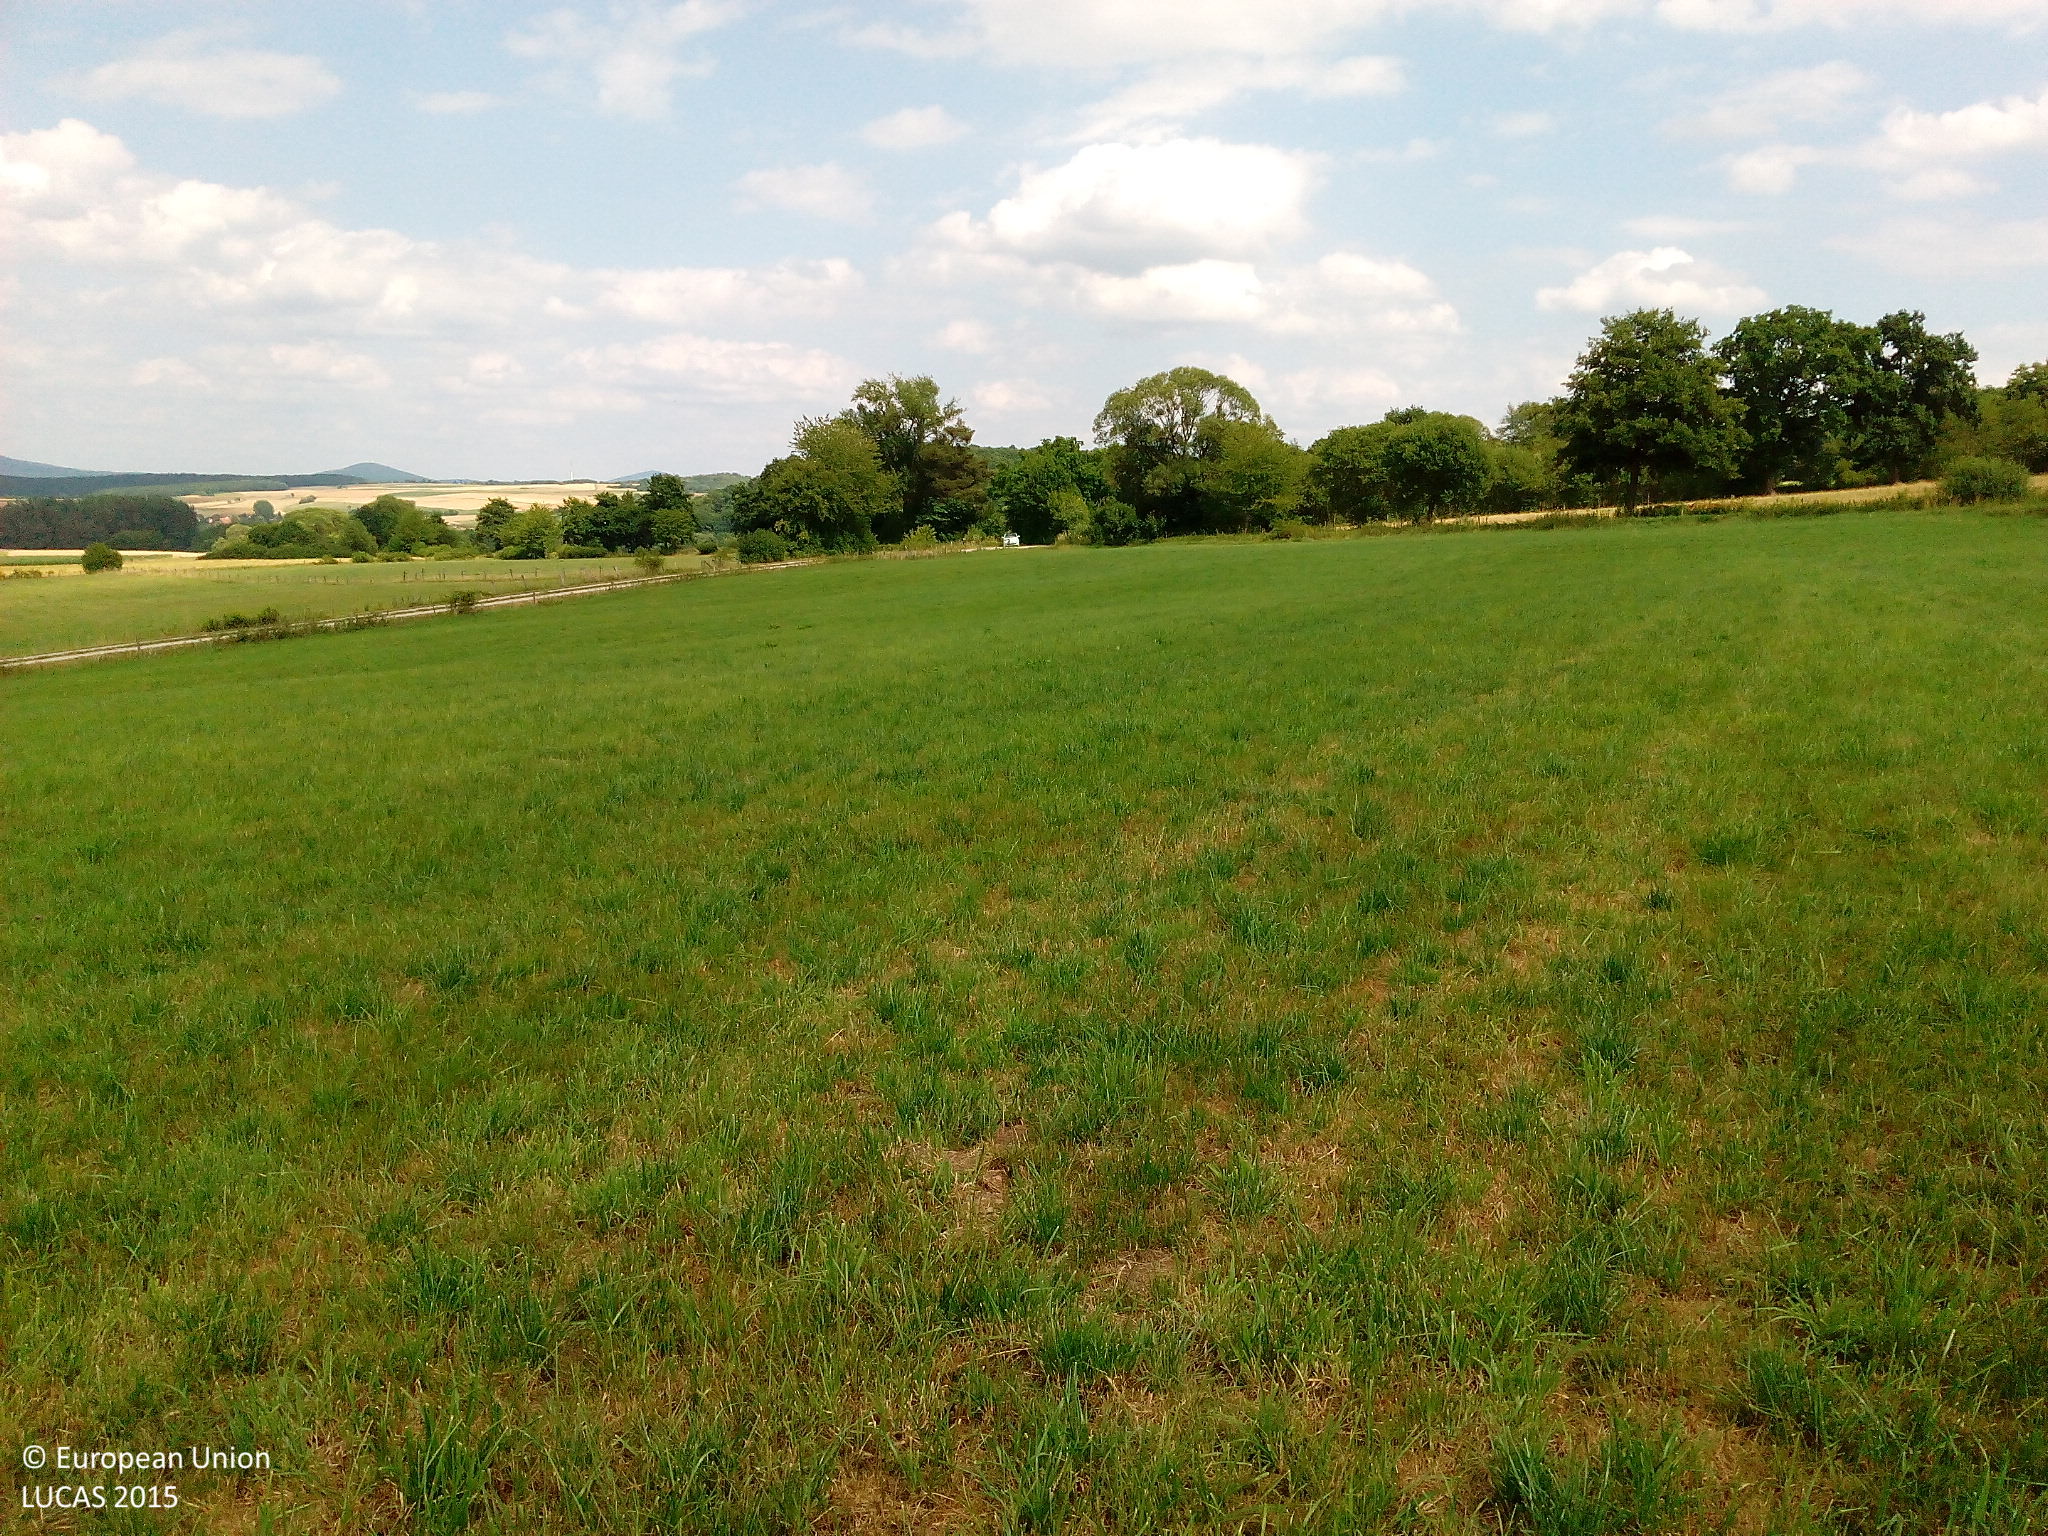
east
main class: Grassland
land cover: Grassland without tree/shrub cover
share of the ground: > 75 %
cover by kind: herbaceous plants 100 %
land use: Agriculture (excluding fallow land and kitchen gardens)
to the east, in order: Grassland without tree/shrub cover; Fences; Grass margins; Paved roads, cycling and walking lanes; Grass margins; Ditches and canals; Fences; Single bushes/trees; Grassland without tree/shrub cover; Fences; Grass margins; Tracks; Grass margins; Ditches and canals; Fences; Lines of trees; Grassland without tree/shrub cover
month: July
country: DE
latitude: 50.7056
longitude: 9.8726
